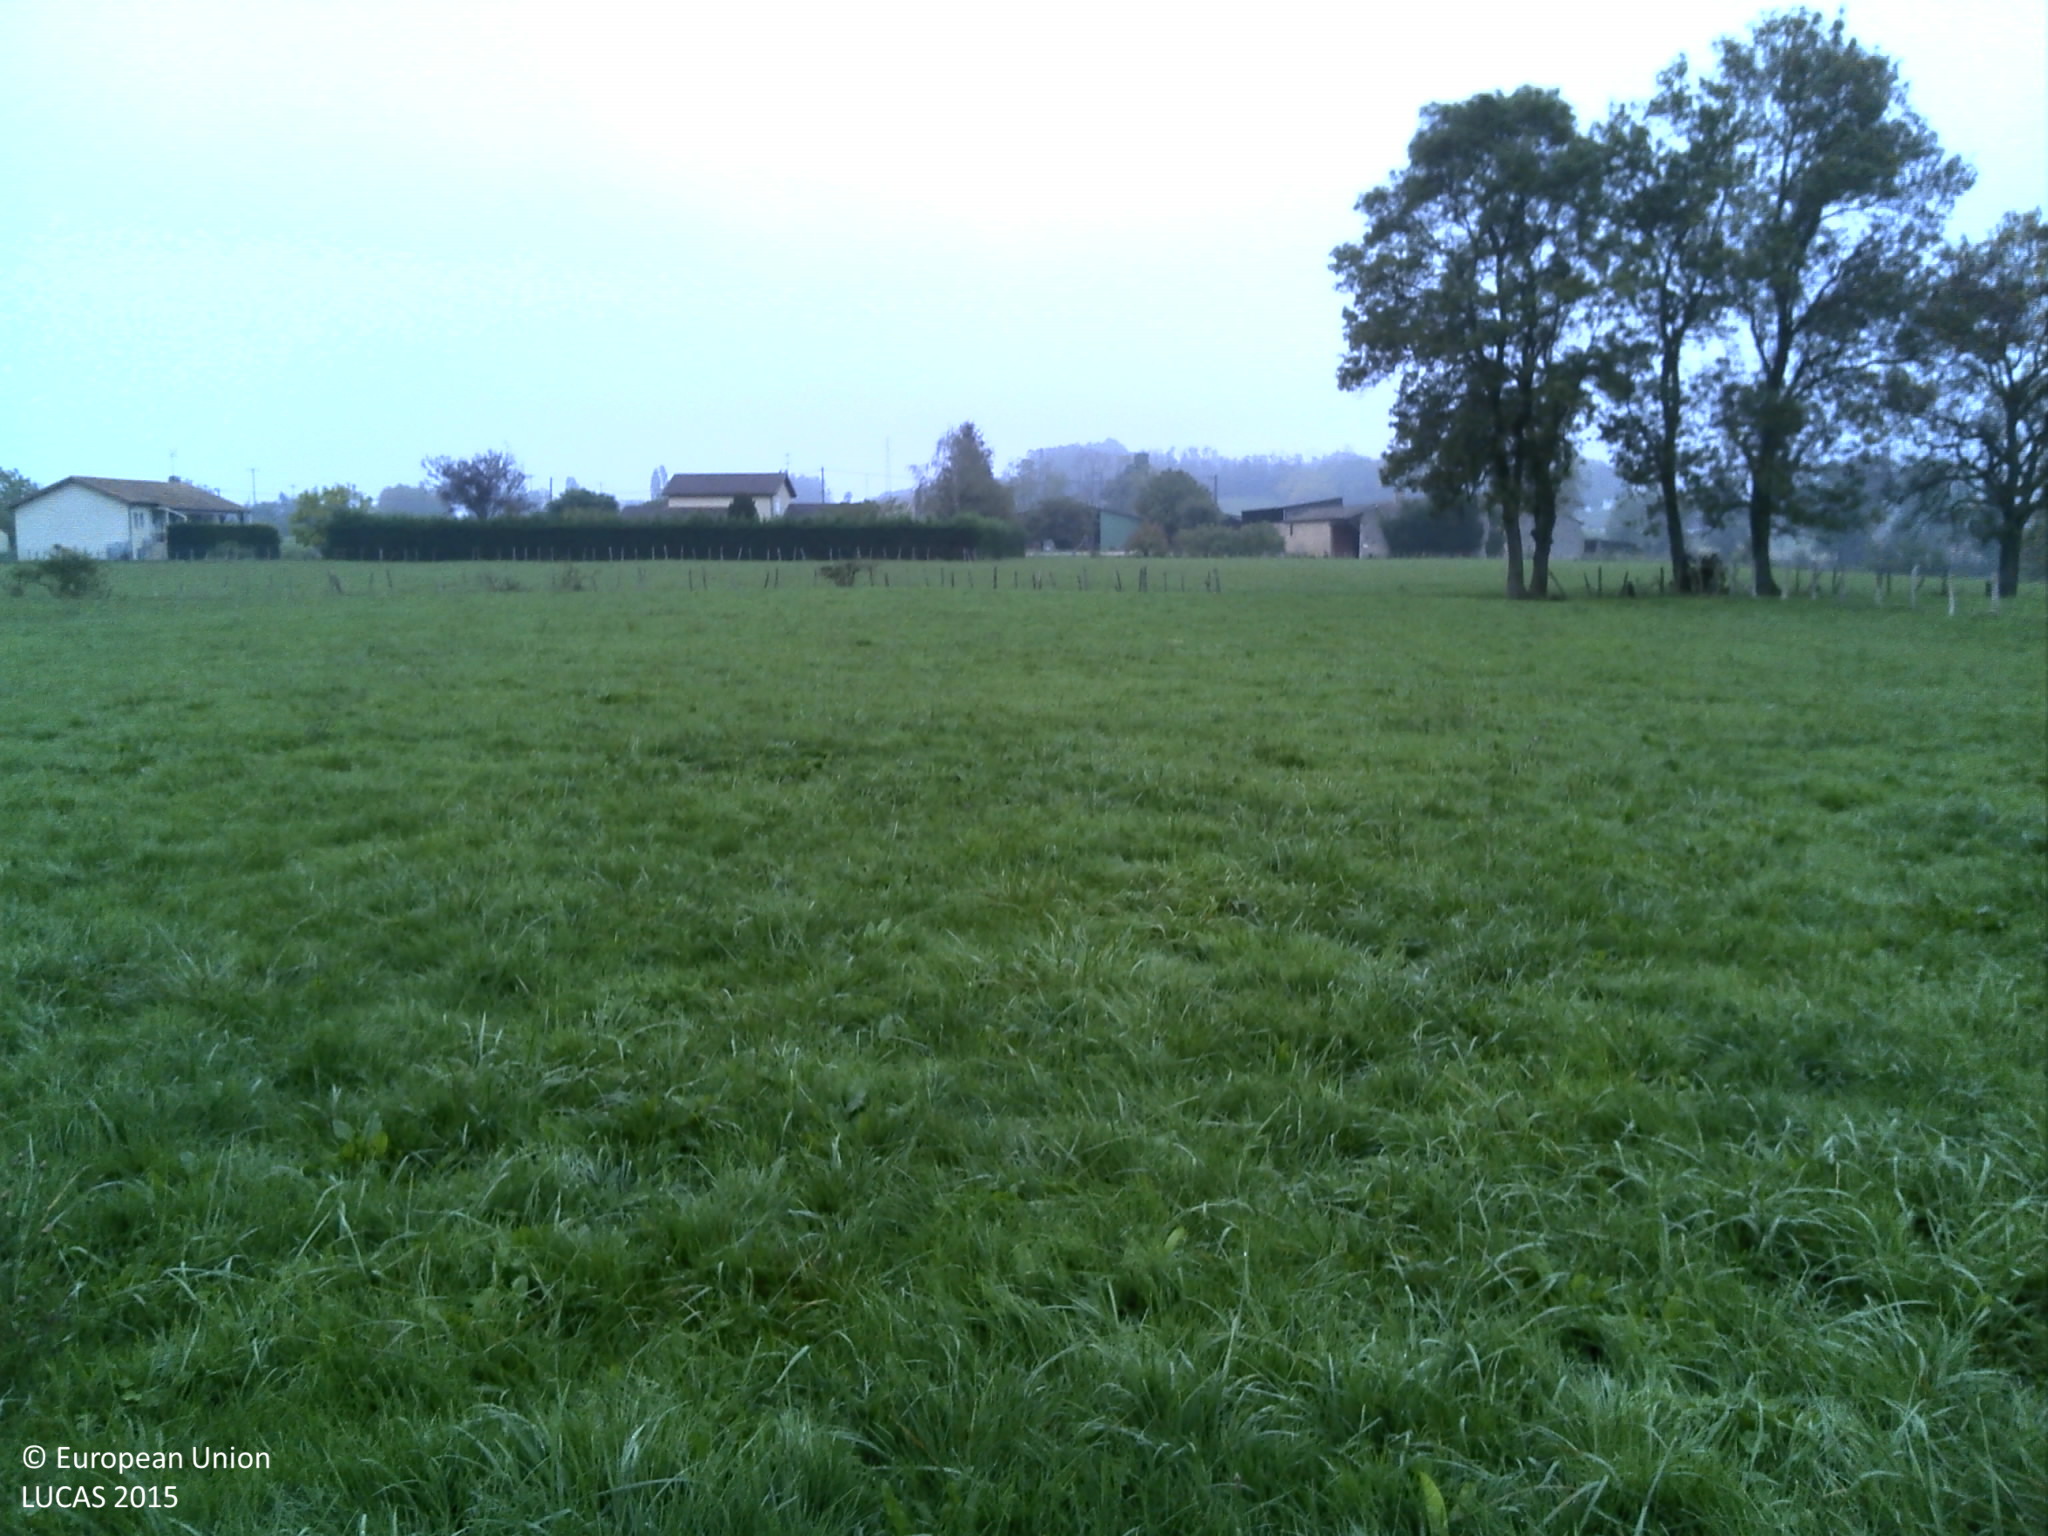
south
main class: Grassland
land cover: Grassland without tree/shrub cover
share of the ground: > 75 %
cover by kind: herbaceous plants 100 %
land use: Agriculture (excluding fallow land and kitchen gardens)
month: October
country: FR
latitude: 46.4263
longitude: 4.8621
